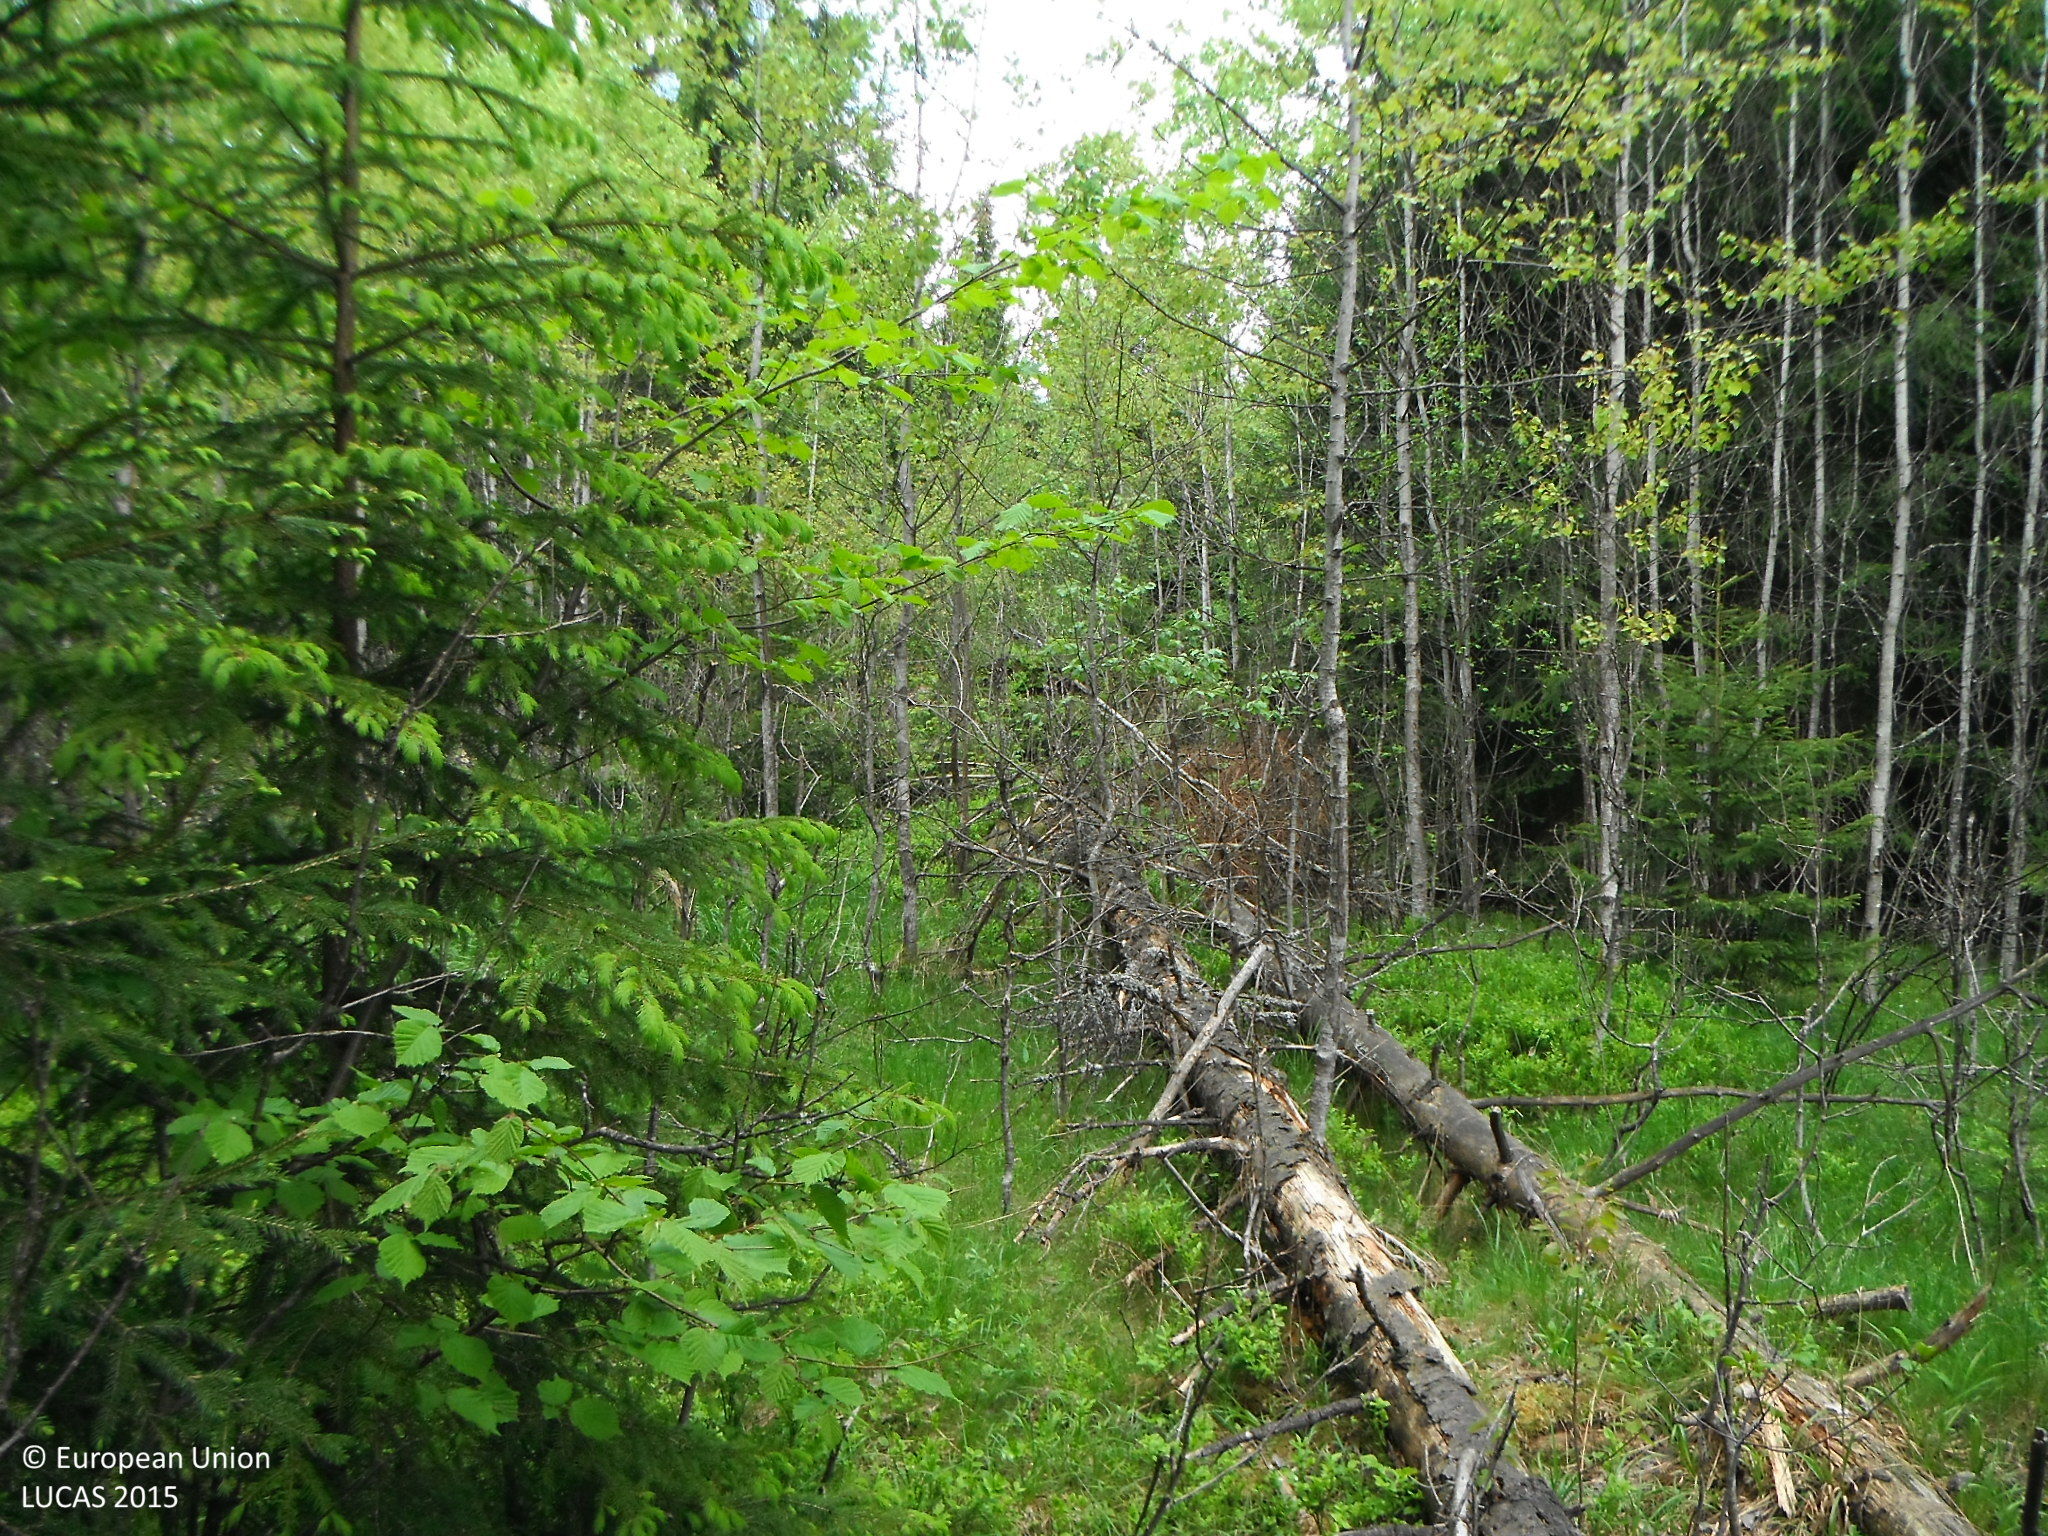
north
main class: Woodland
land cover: Spruce dominated coniferous woodland
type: alpine coniferous forest
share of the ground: > 75 %
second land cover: Spontaneously vegetated surfaces
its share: 25 - 50 %
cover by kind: coniferous forest trees 75 %, herbaceous plants 25 %
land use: Forestry
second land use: Agriculture (excluding fallow land and kitchen gardens)
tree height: > 5 m
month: June
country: SK
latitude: 49.1116
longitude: 19.7690
